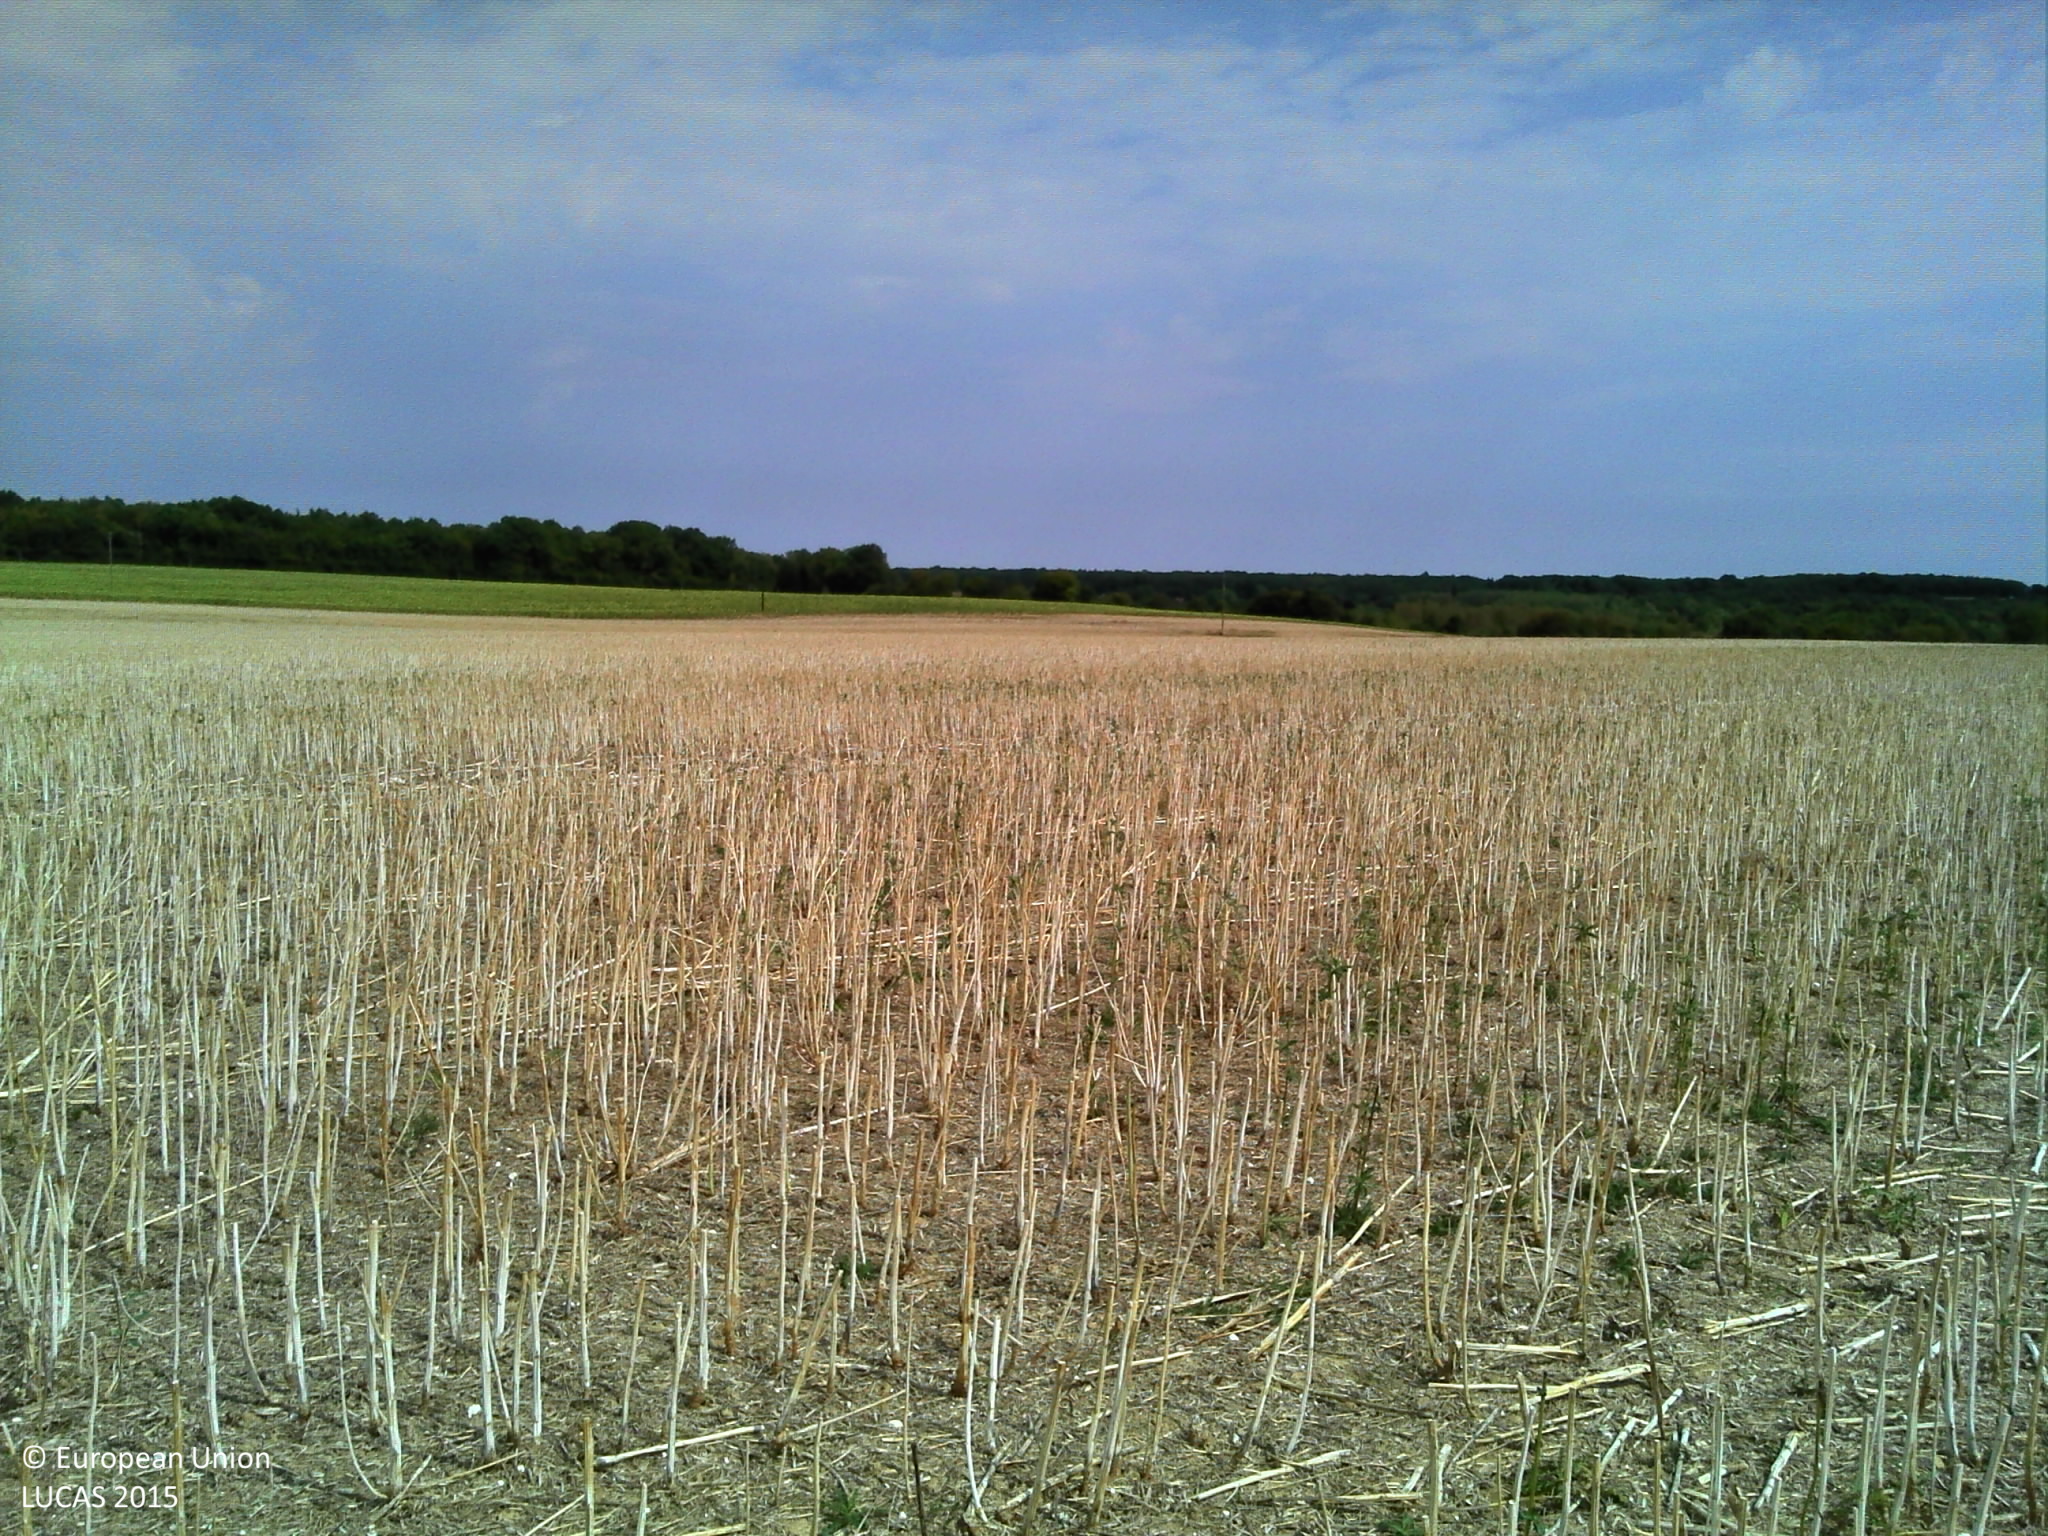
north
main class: Cropland
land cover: Rape and turnip rape
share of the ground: > 75 %
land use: Agriculture (excluding fallow land and kitchen gardens)
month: August
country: FR
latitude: 47.7201
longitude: 3.1288
